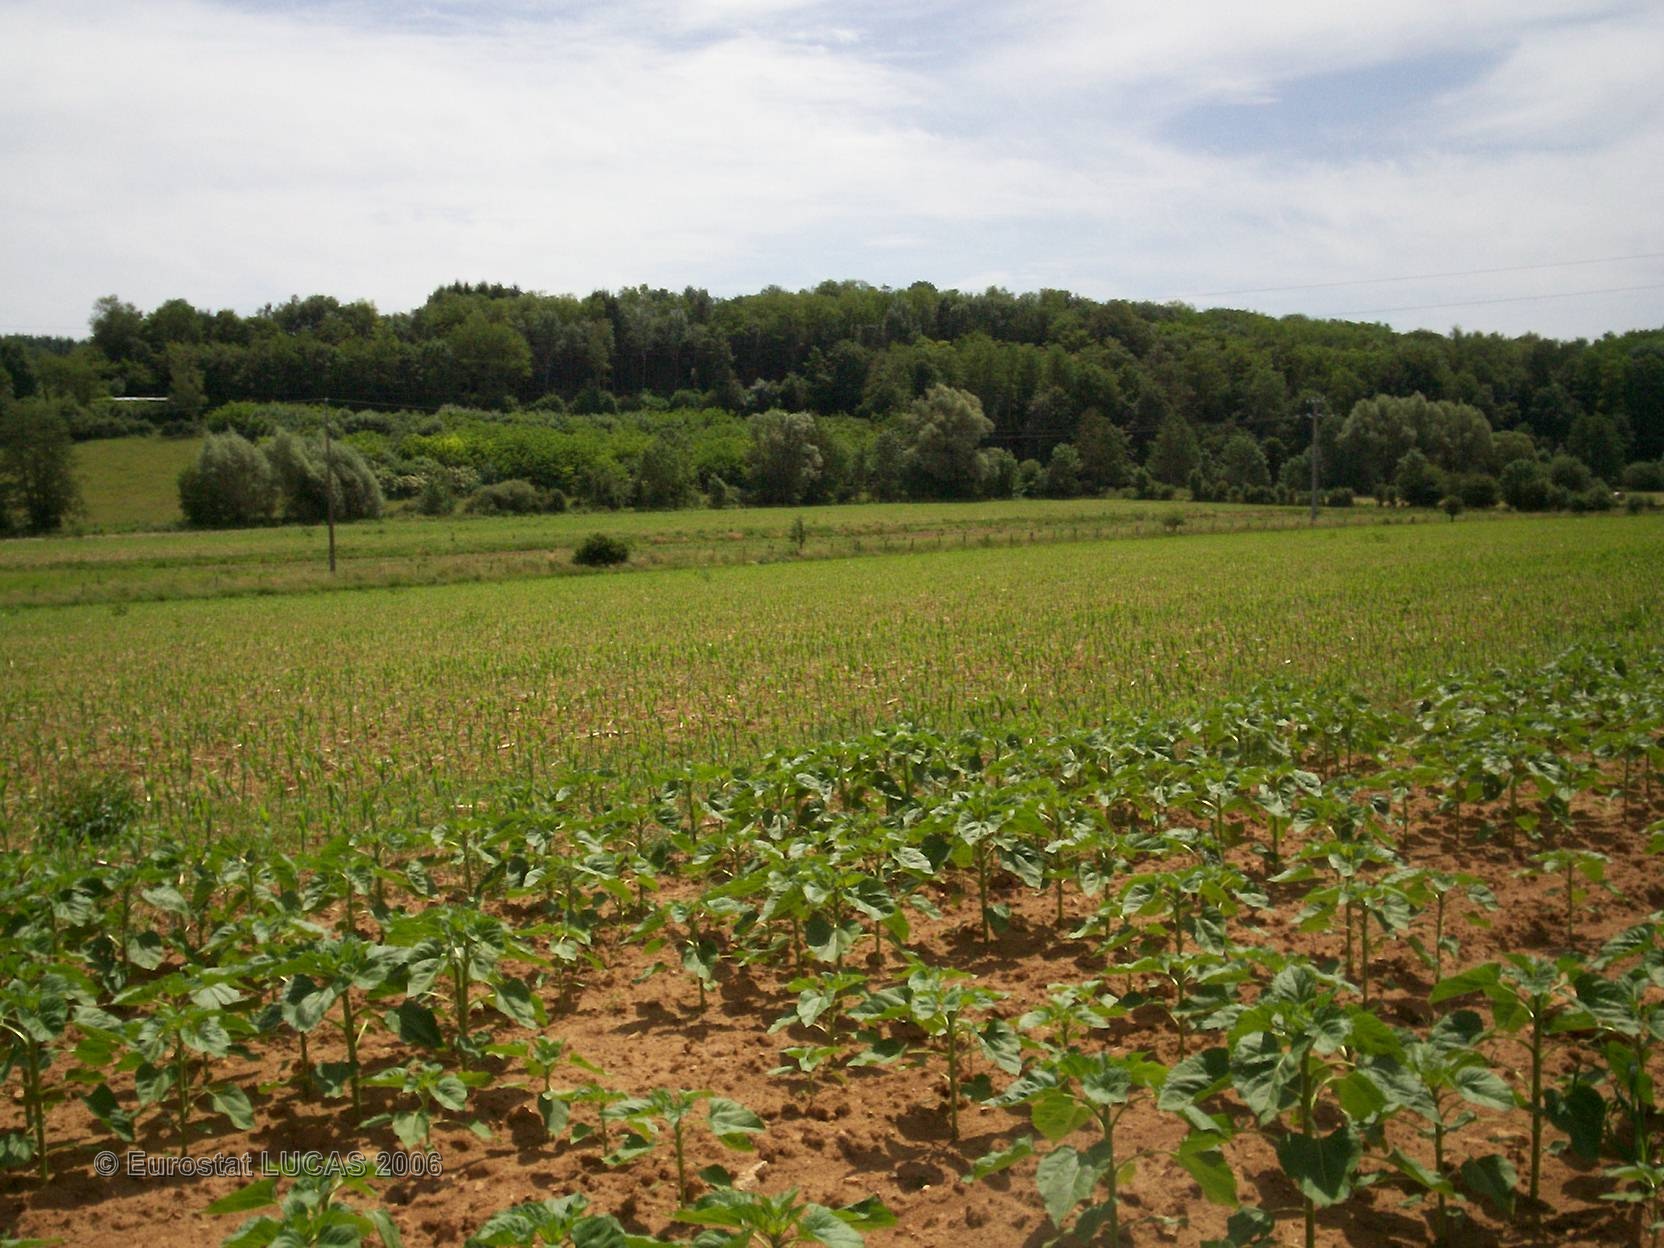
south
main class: Cropland
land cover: Sunflower
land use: Agriculture (excluding fallow land and kitchen gardens)
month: June
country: FR
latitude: 47.6671
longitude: 6.0725
